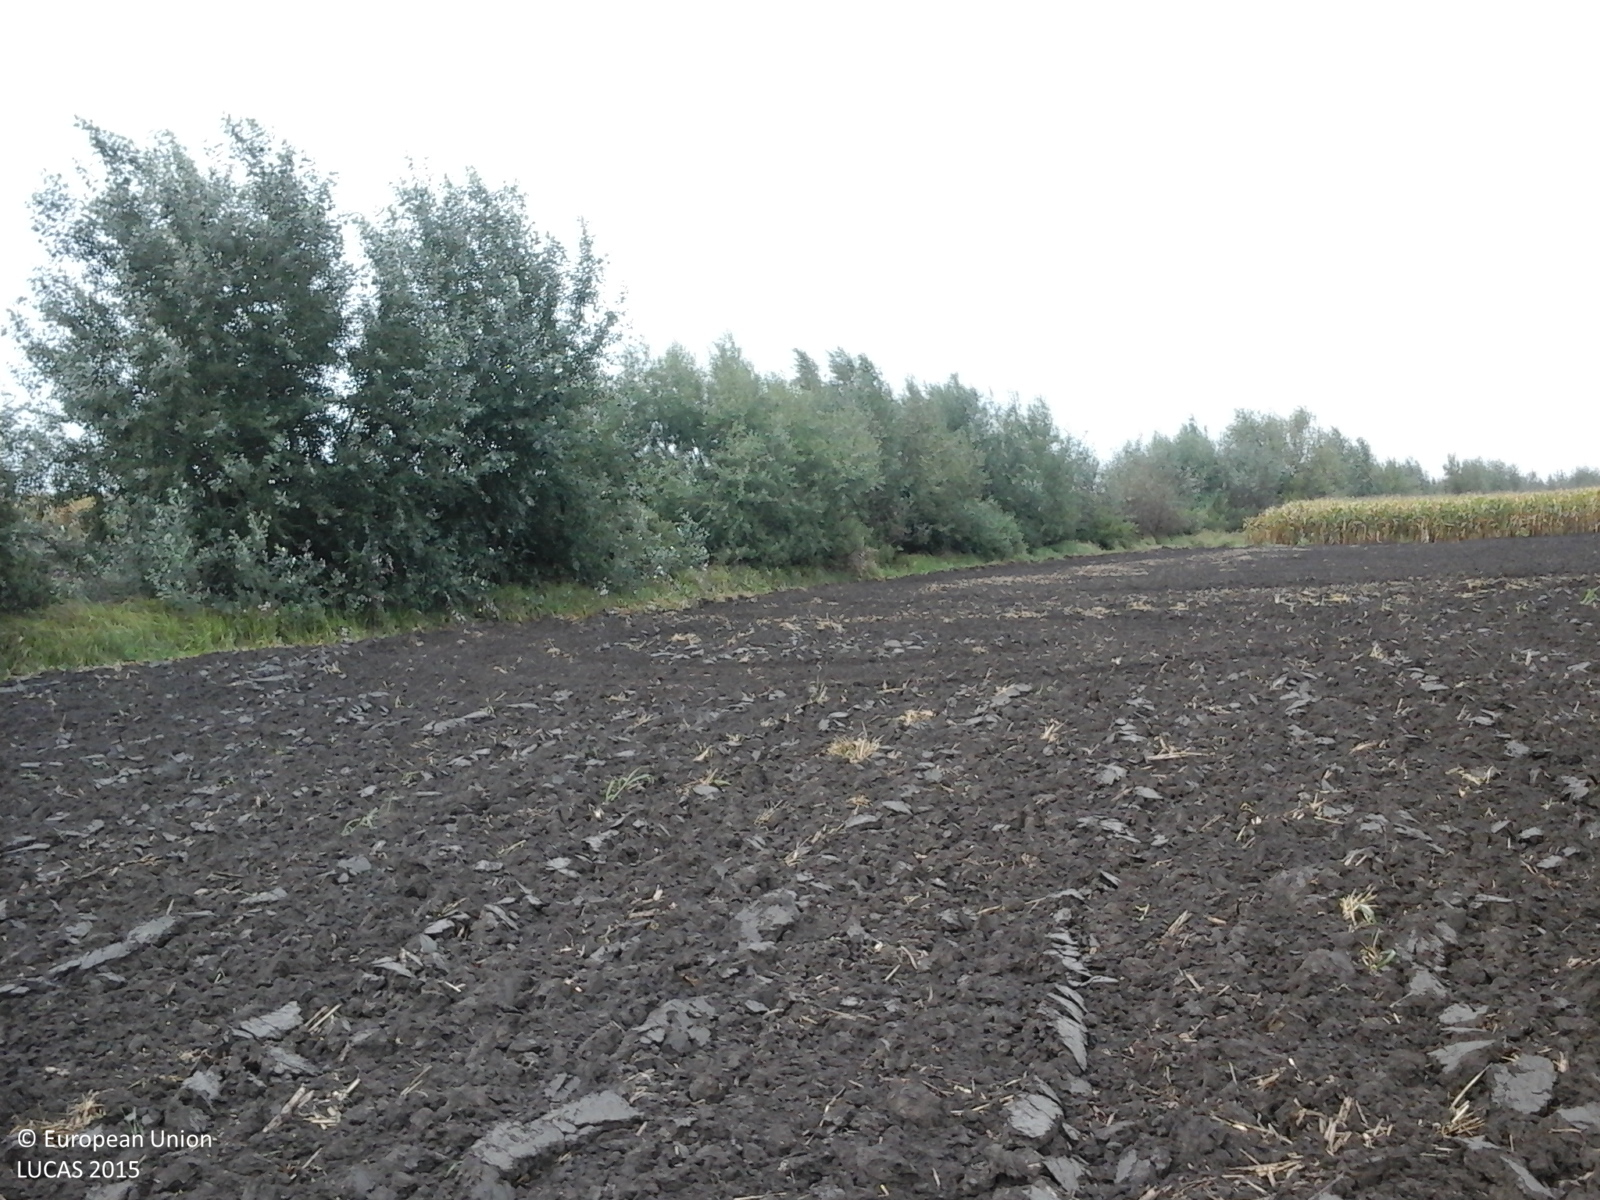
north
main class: Cropland
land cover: Common wheat
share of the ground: < 10 %
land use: Agriculture (excluding fallow land and kitchen gardens)
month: September
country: RO
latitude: 47.4533
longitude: 22.1882
